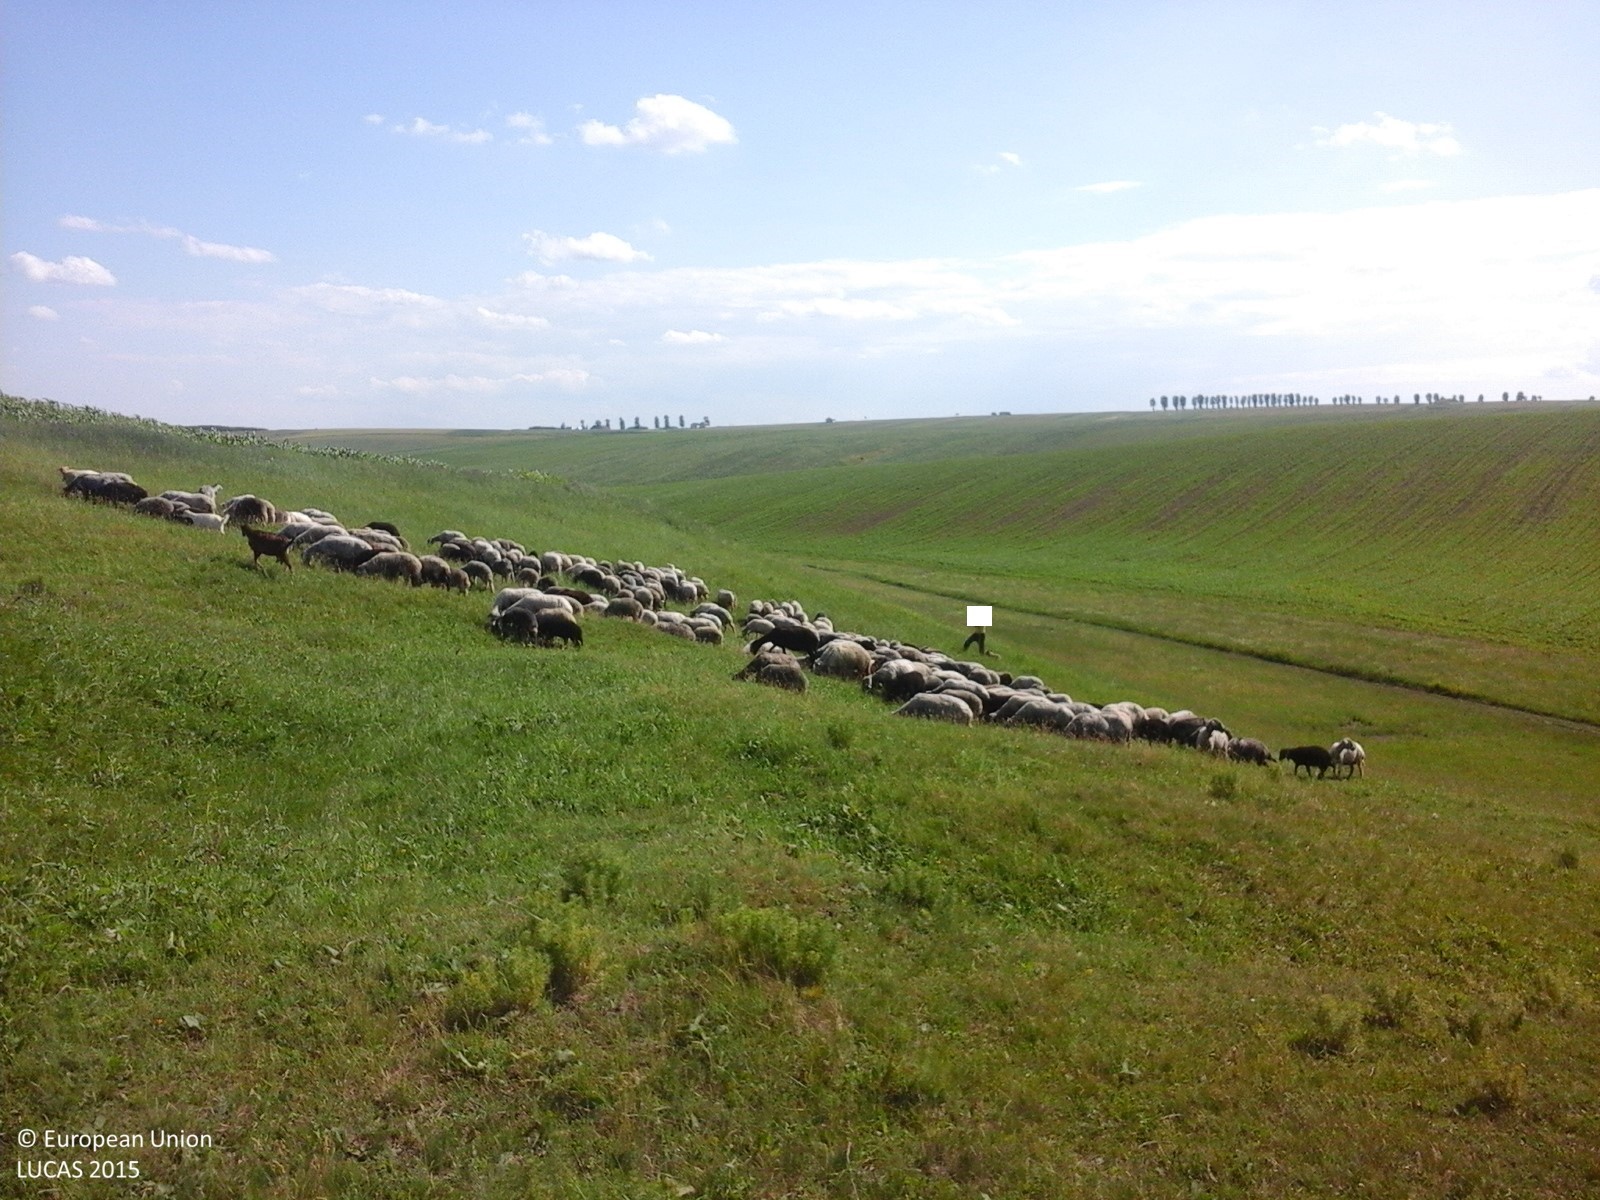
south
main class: Grassland
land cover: Grassland without tree/shrub cover
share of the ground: > 75 %
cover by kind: herbaceous plants 100 %
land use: Agriculture (excluding fallow land and kitchen gardens)
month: June
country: RO
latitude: 48.1934
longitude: 26.6581
